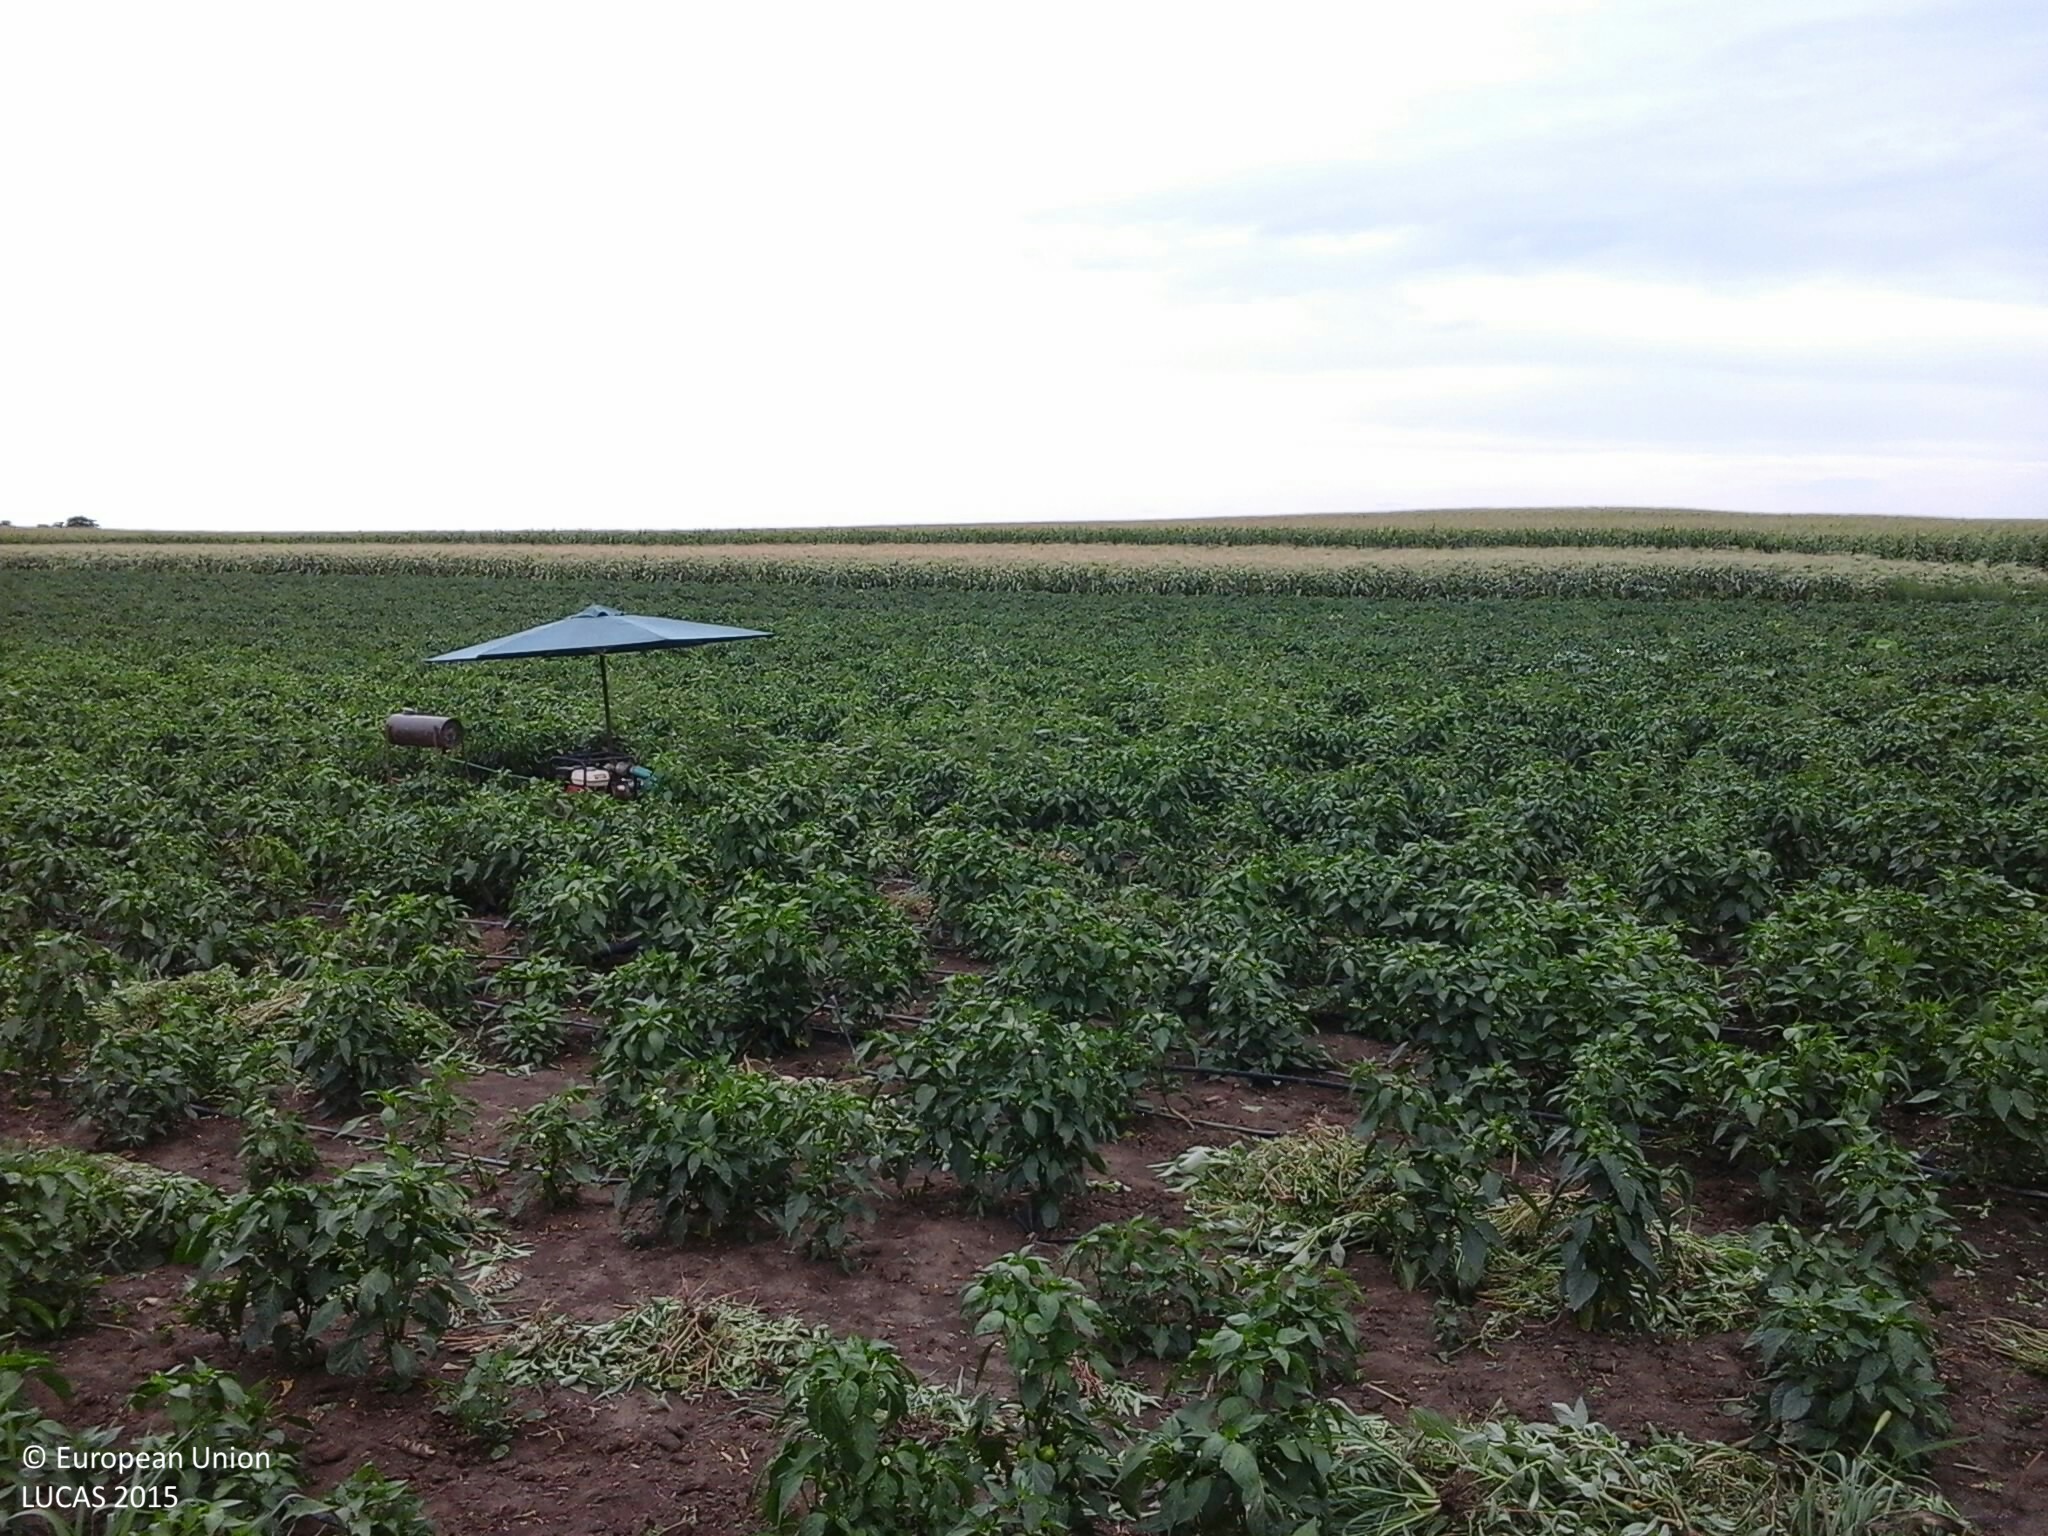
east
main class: Cropland
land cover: Maize
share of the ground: > 75 %
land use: Agriculture (excluding fallow land and kitchen gardens)
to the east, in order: Maize; Other fresh vegetables; Maize; Common wheat; Maize
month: July
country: HU
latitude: 47.8054
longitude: 21.4602
